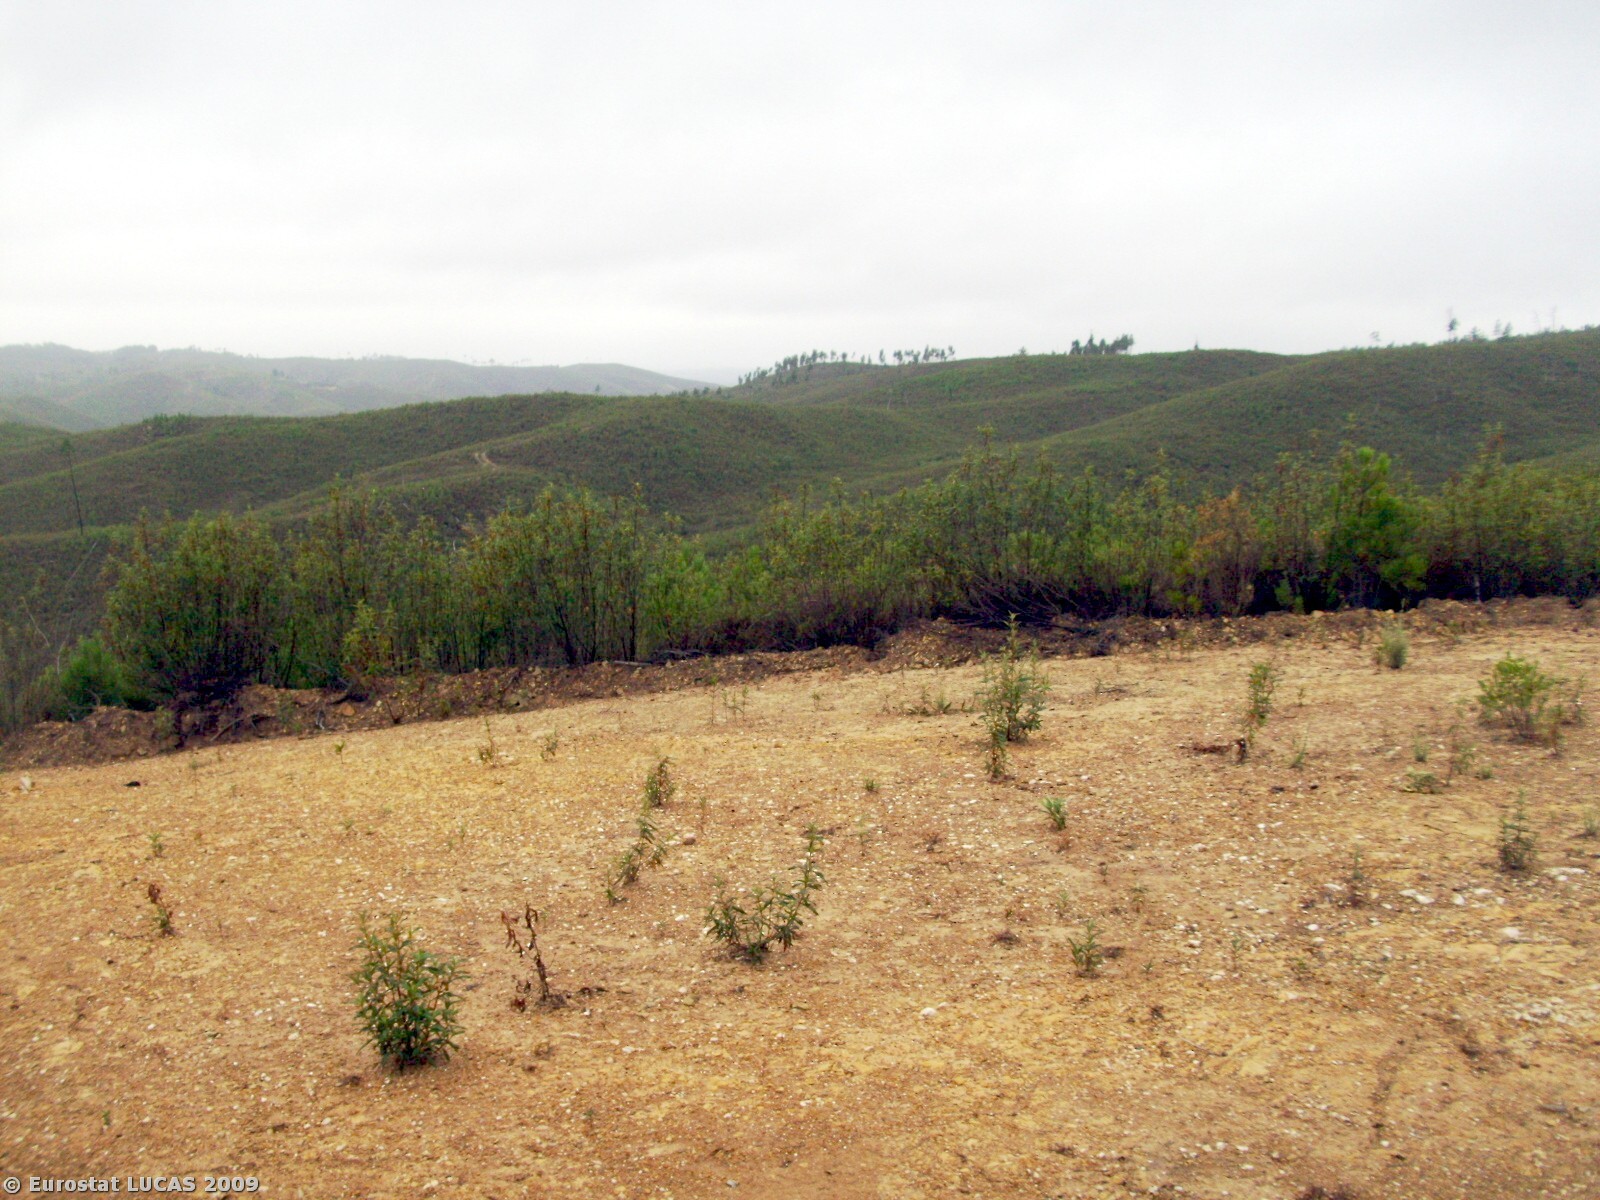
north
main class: Shrubland
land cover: Shrubland with sparse tree cover
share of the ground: > 75 %
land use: Unused
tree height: > 5 m
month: July
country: PT
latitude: 39.7162
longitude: -8.0881
